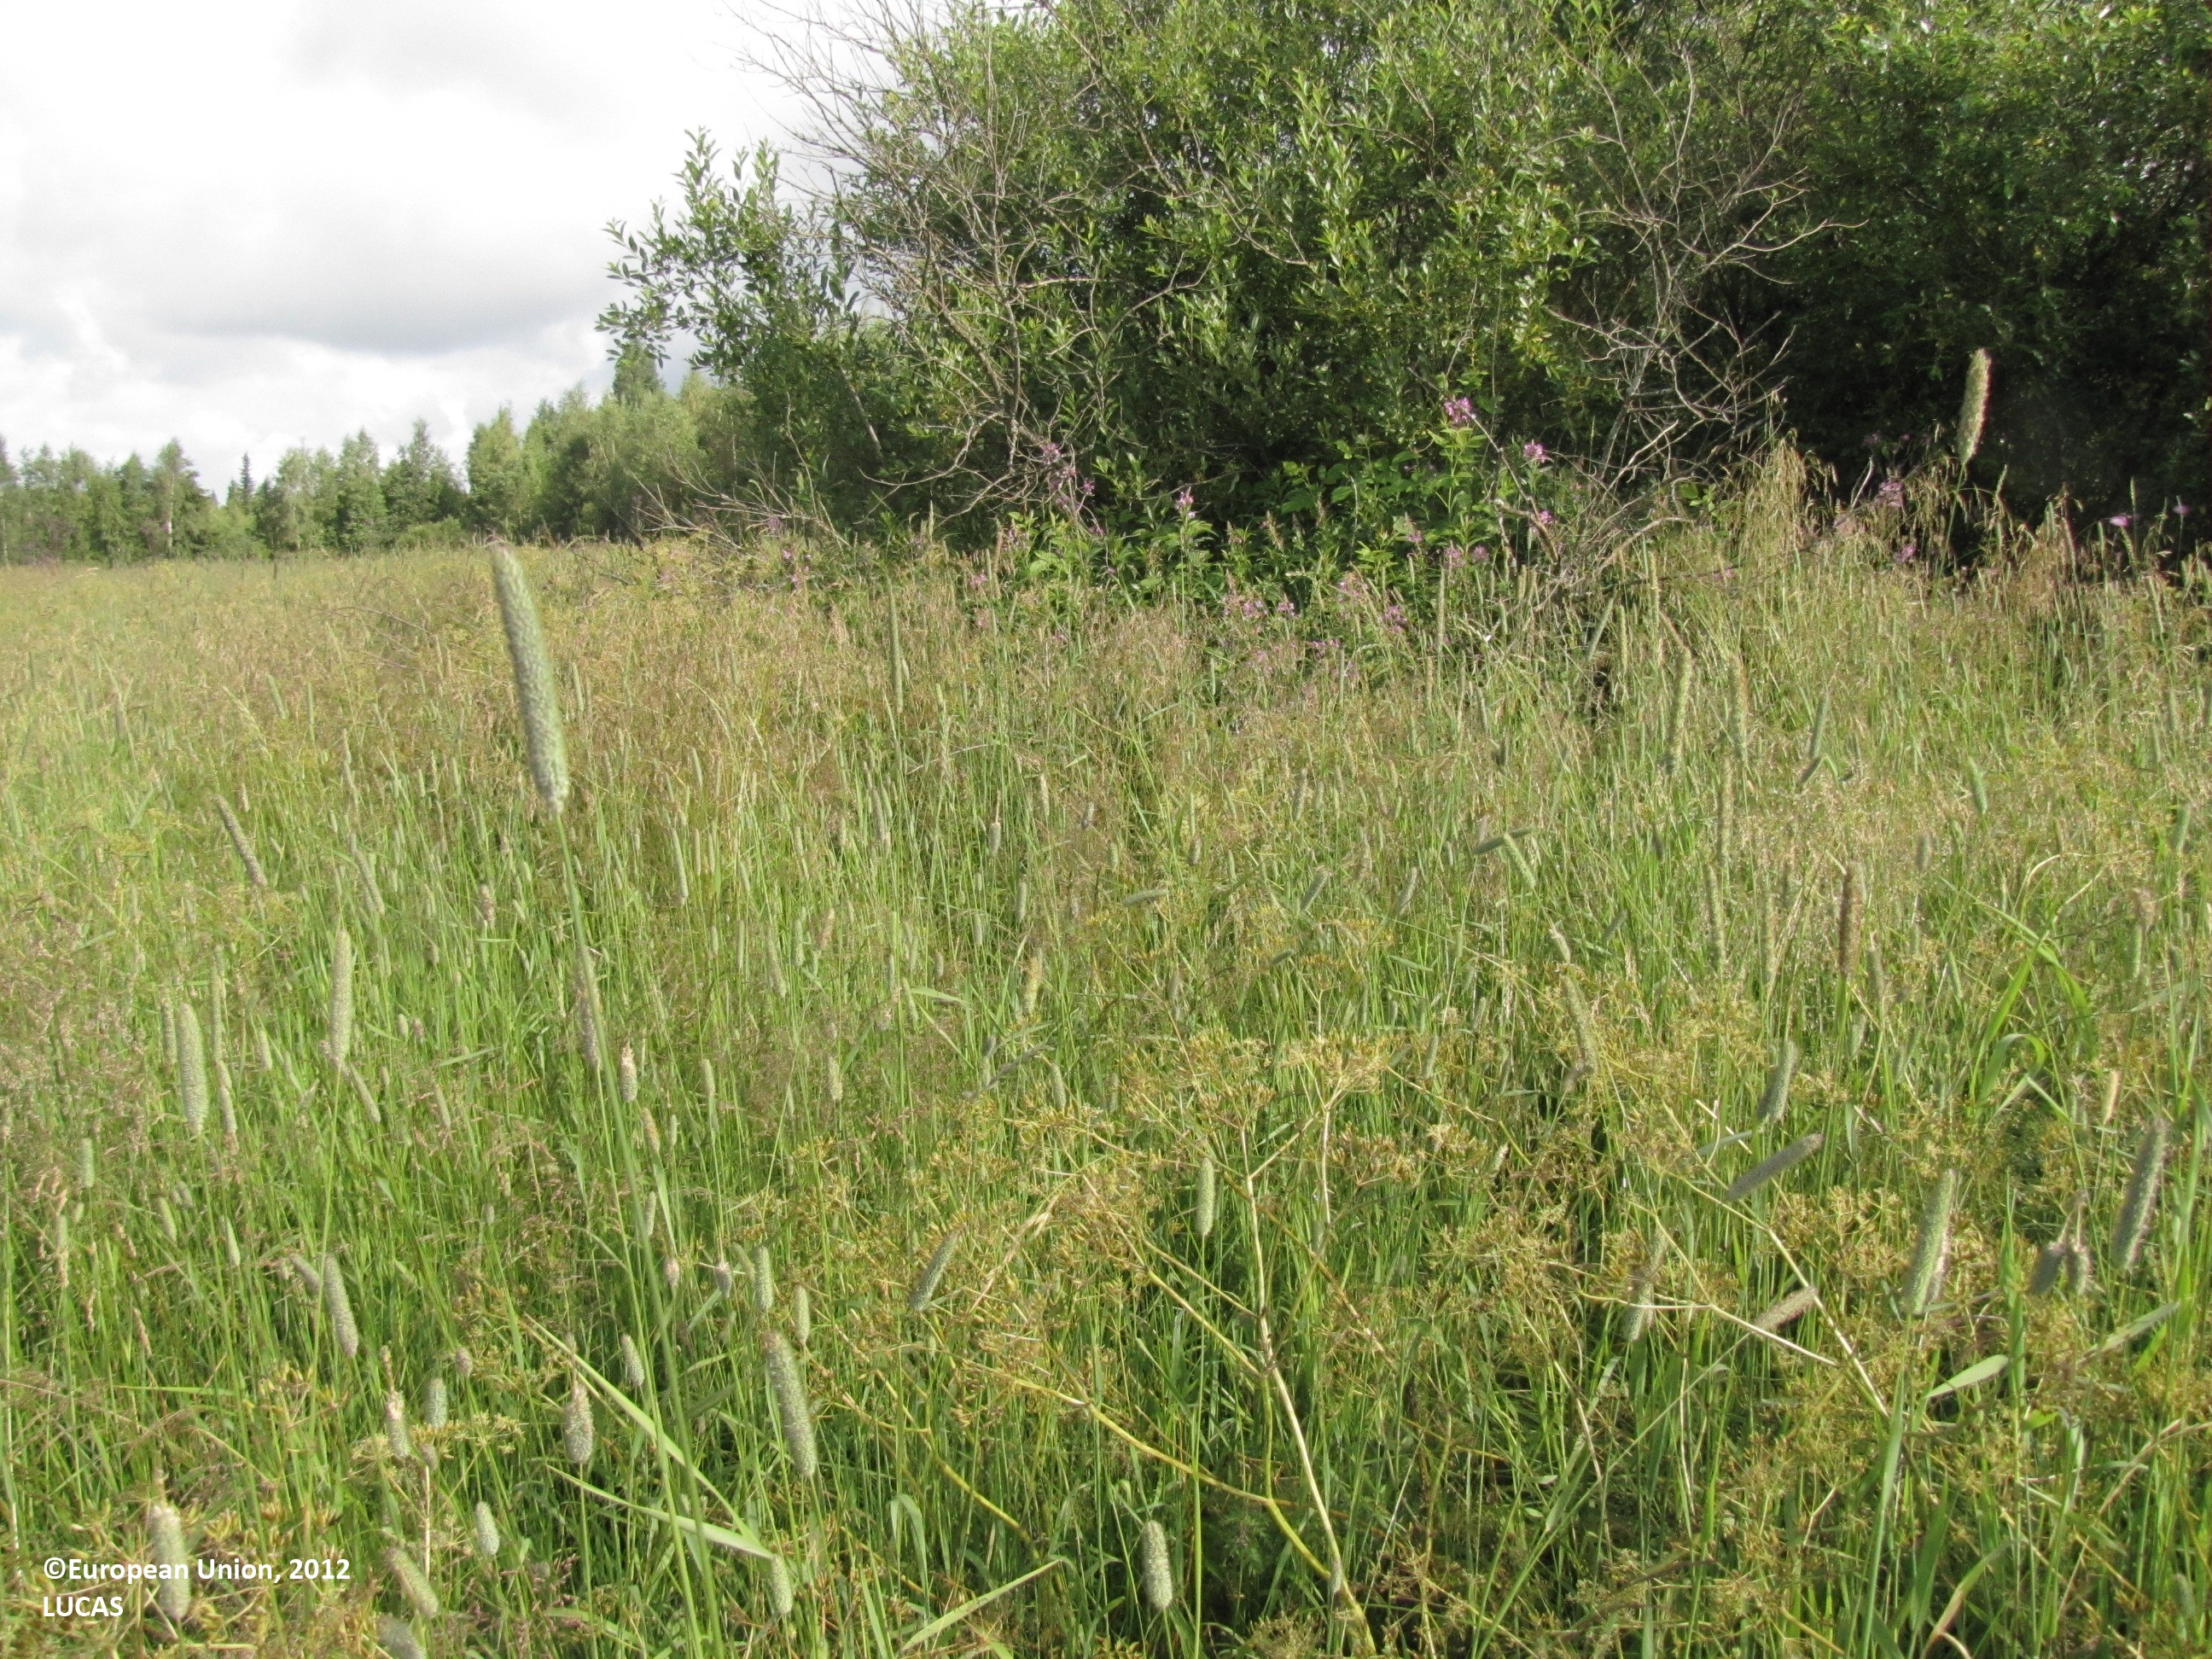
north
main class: Grassland
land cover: Spontaneously vegetated surfaces
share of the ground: > 75 %
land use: Agriculture (excluding fallow land and kitchen gardens)
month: July
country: FI
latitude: 62.6860
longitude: 23.0128
